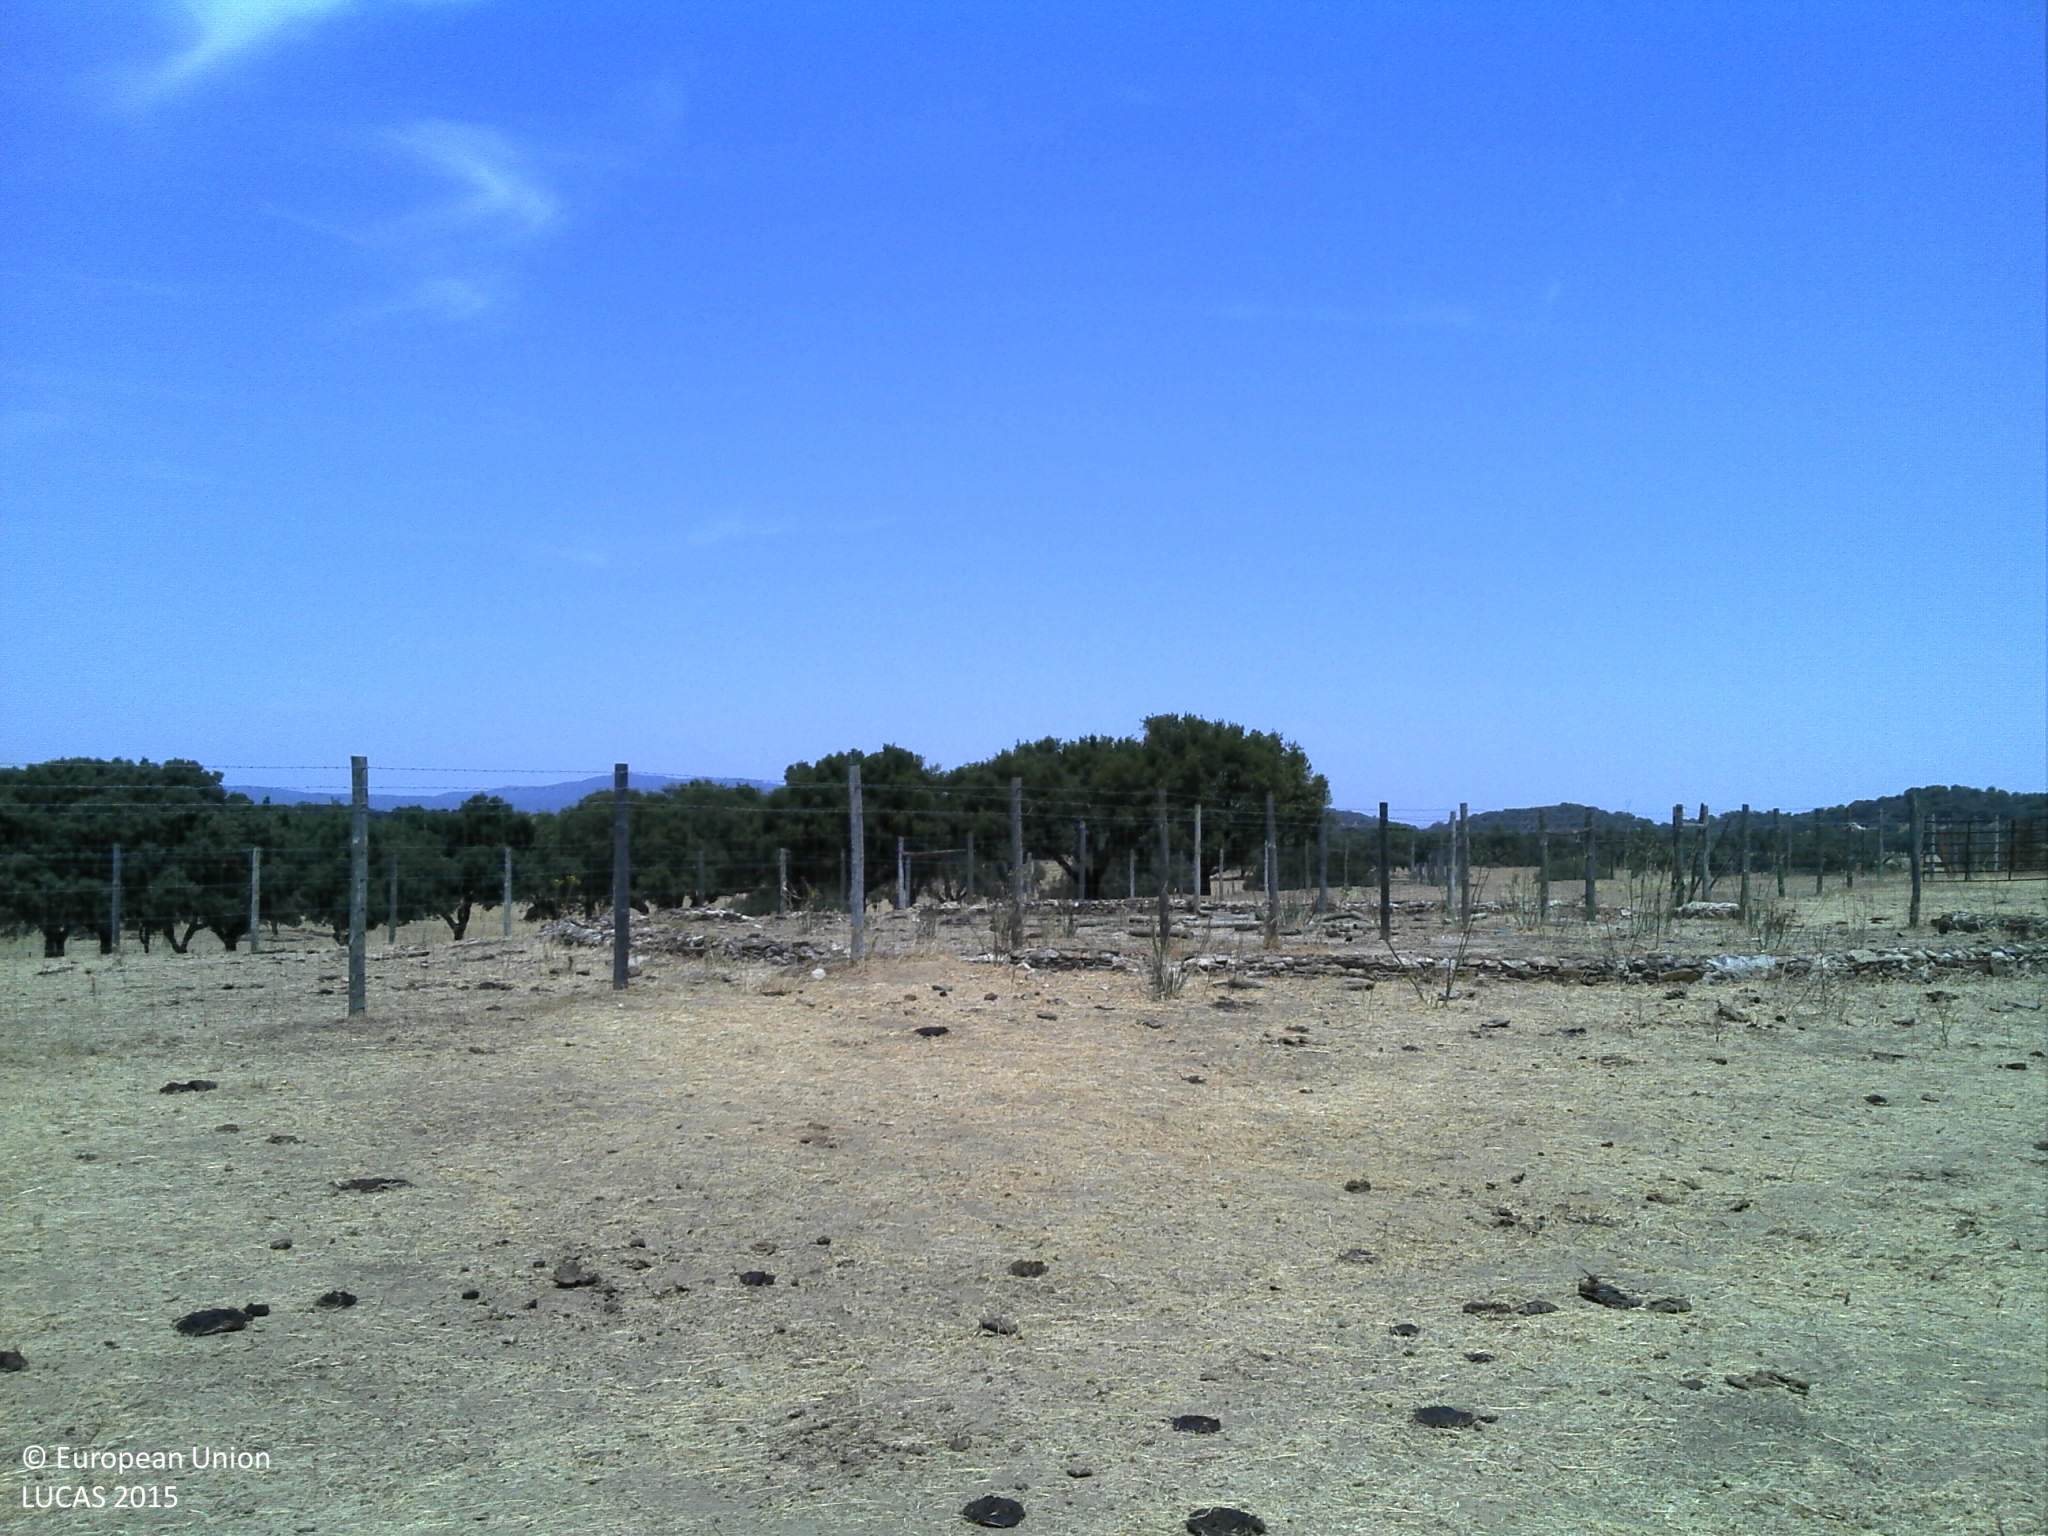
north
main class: Cropland
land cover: Olive groves
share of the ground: 25 - 50 %
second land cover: Grassland without tree/shrub cover
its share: < 10 %
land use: Agriculture (excluding fallow land and kitchen gardens)
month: July
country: PT
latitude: 38.6383
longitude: -7.5286
